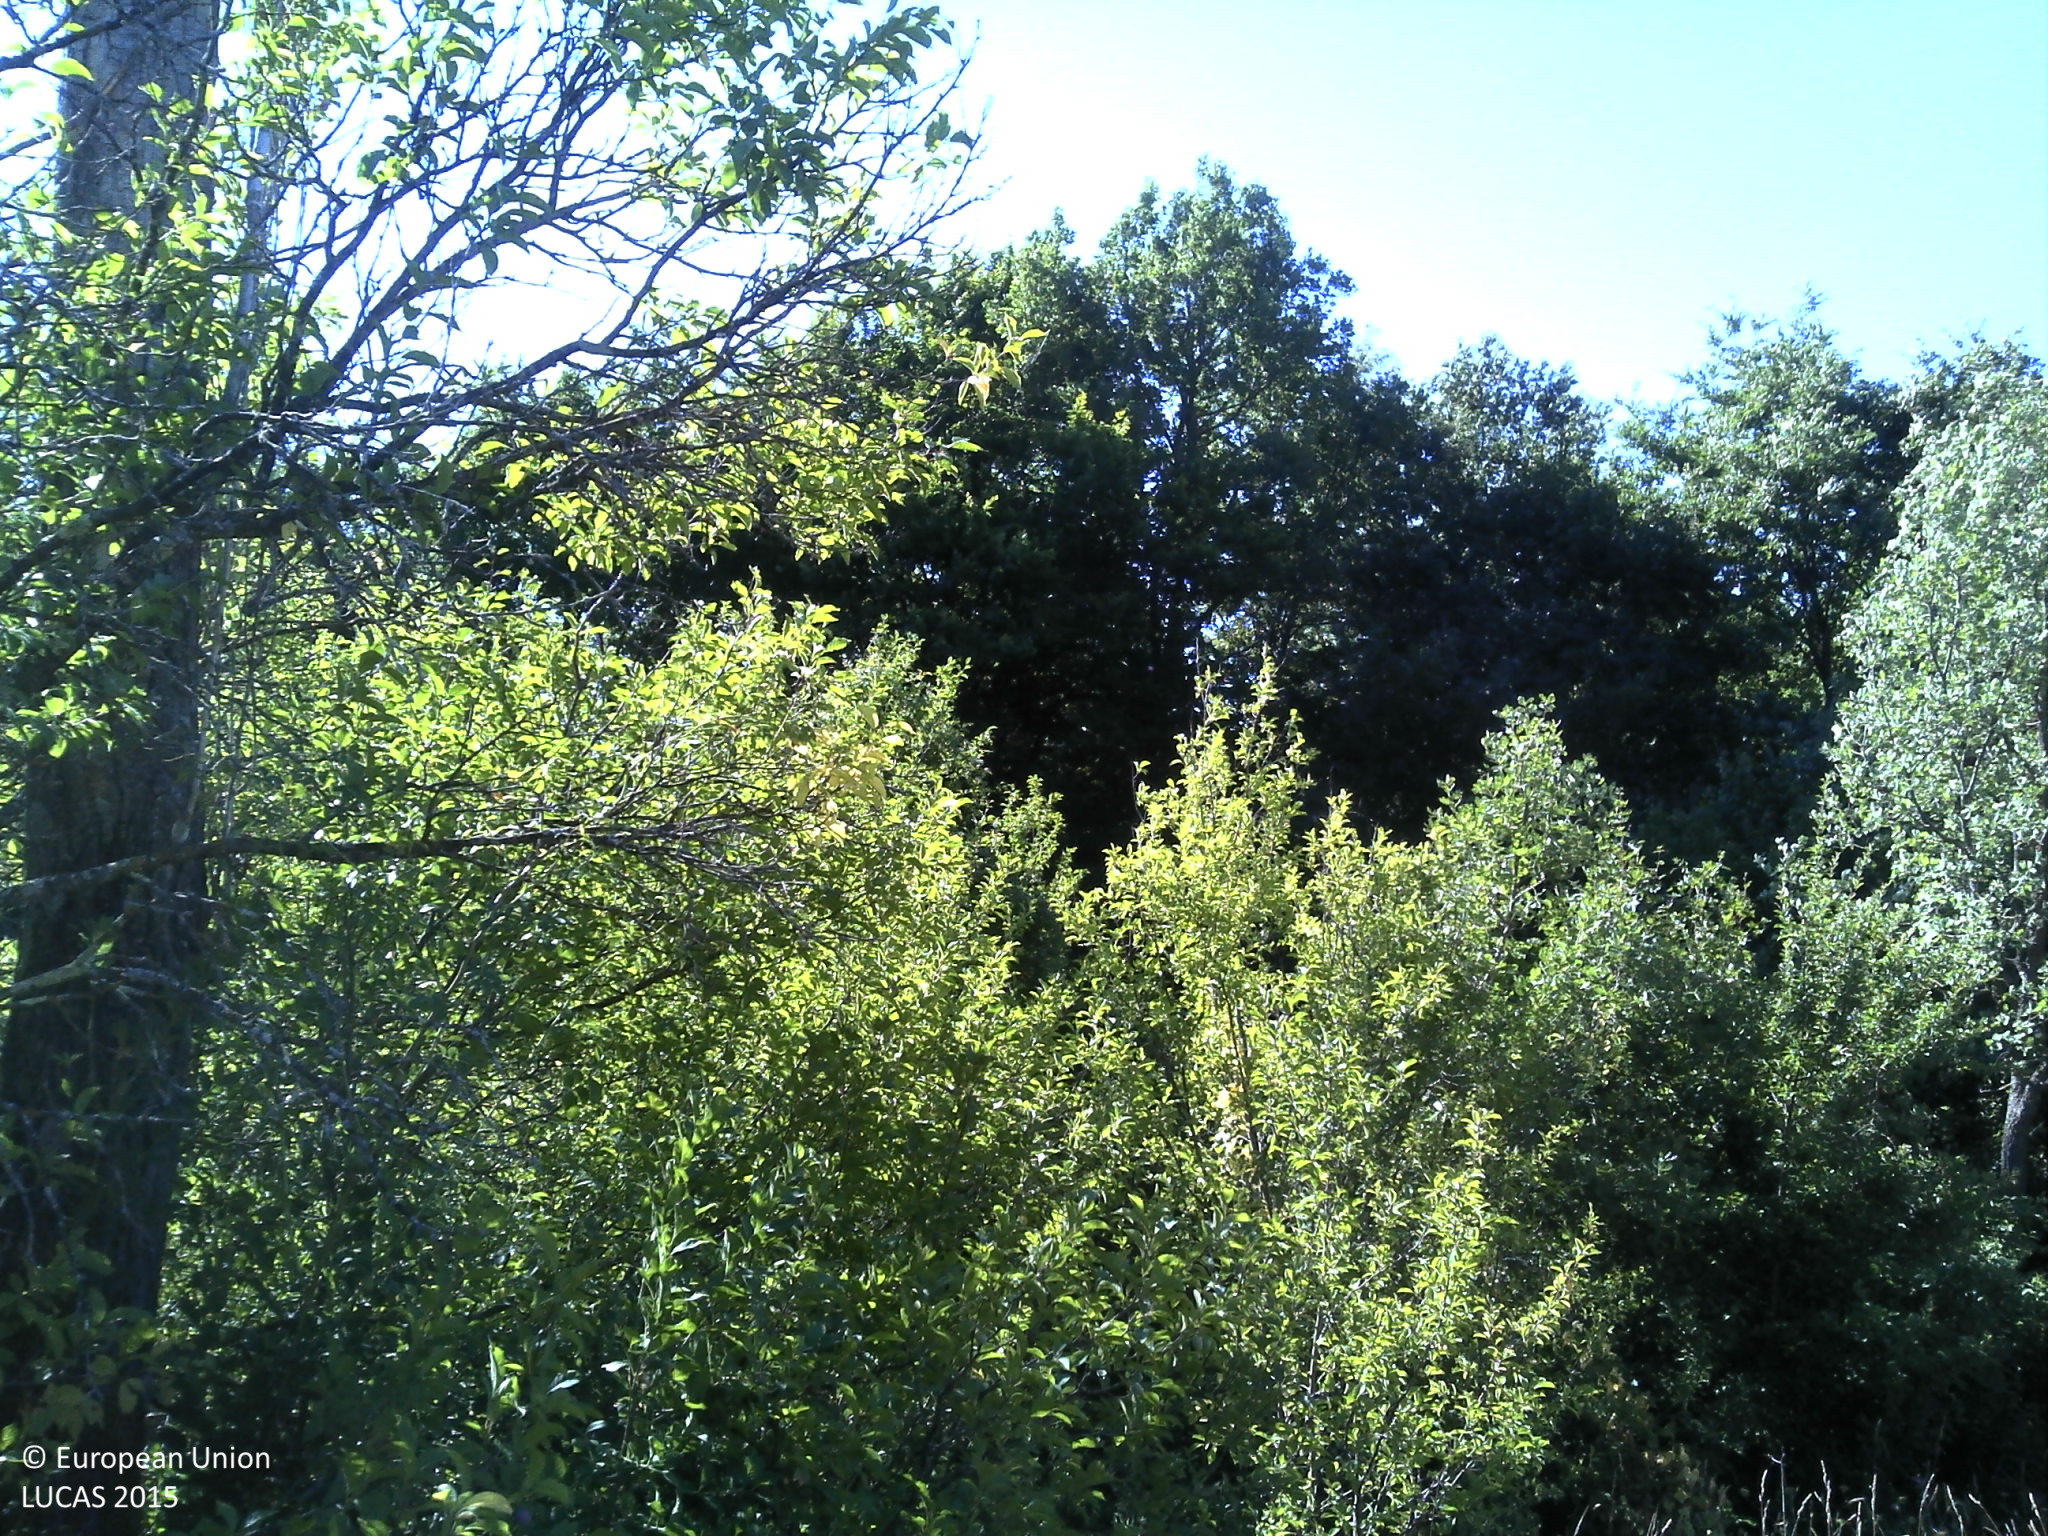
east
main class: Woodland
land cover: Broadleaved woodland
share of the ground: 25 - 50 %
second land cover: Grassland without tree/shrub cover
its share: > 75 %
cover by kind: herbaceous plants 65 %, broadleaved forest trees 25 %, shrubs 10 %
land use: Forestry
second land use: Agriculture (excluding fallow land and kitchen gardens)
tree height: < 5 m
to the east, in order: Broadleaved woodland; Grassland without tree/shrub cover; Grassland with sparse tree/shrub cover; Shrubland with sparse tree cover; Grassland with sparse tree/shrub cover; Shrubland with sparse tree cover; Grassland with sparse tree/shrub cover; Shrubland with sparse tree cover; Broadleaved woodland; Shrubland with sparse tree cover; Grassland with sparse tree/shrub cover
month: July
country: HR
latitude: 44.1331
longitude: 16.1297
